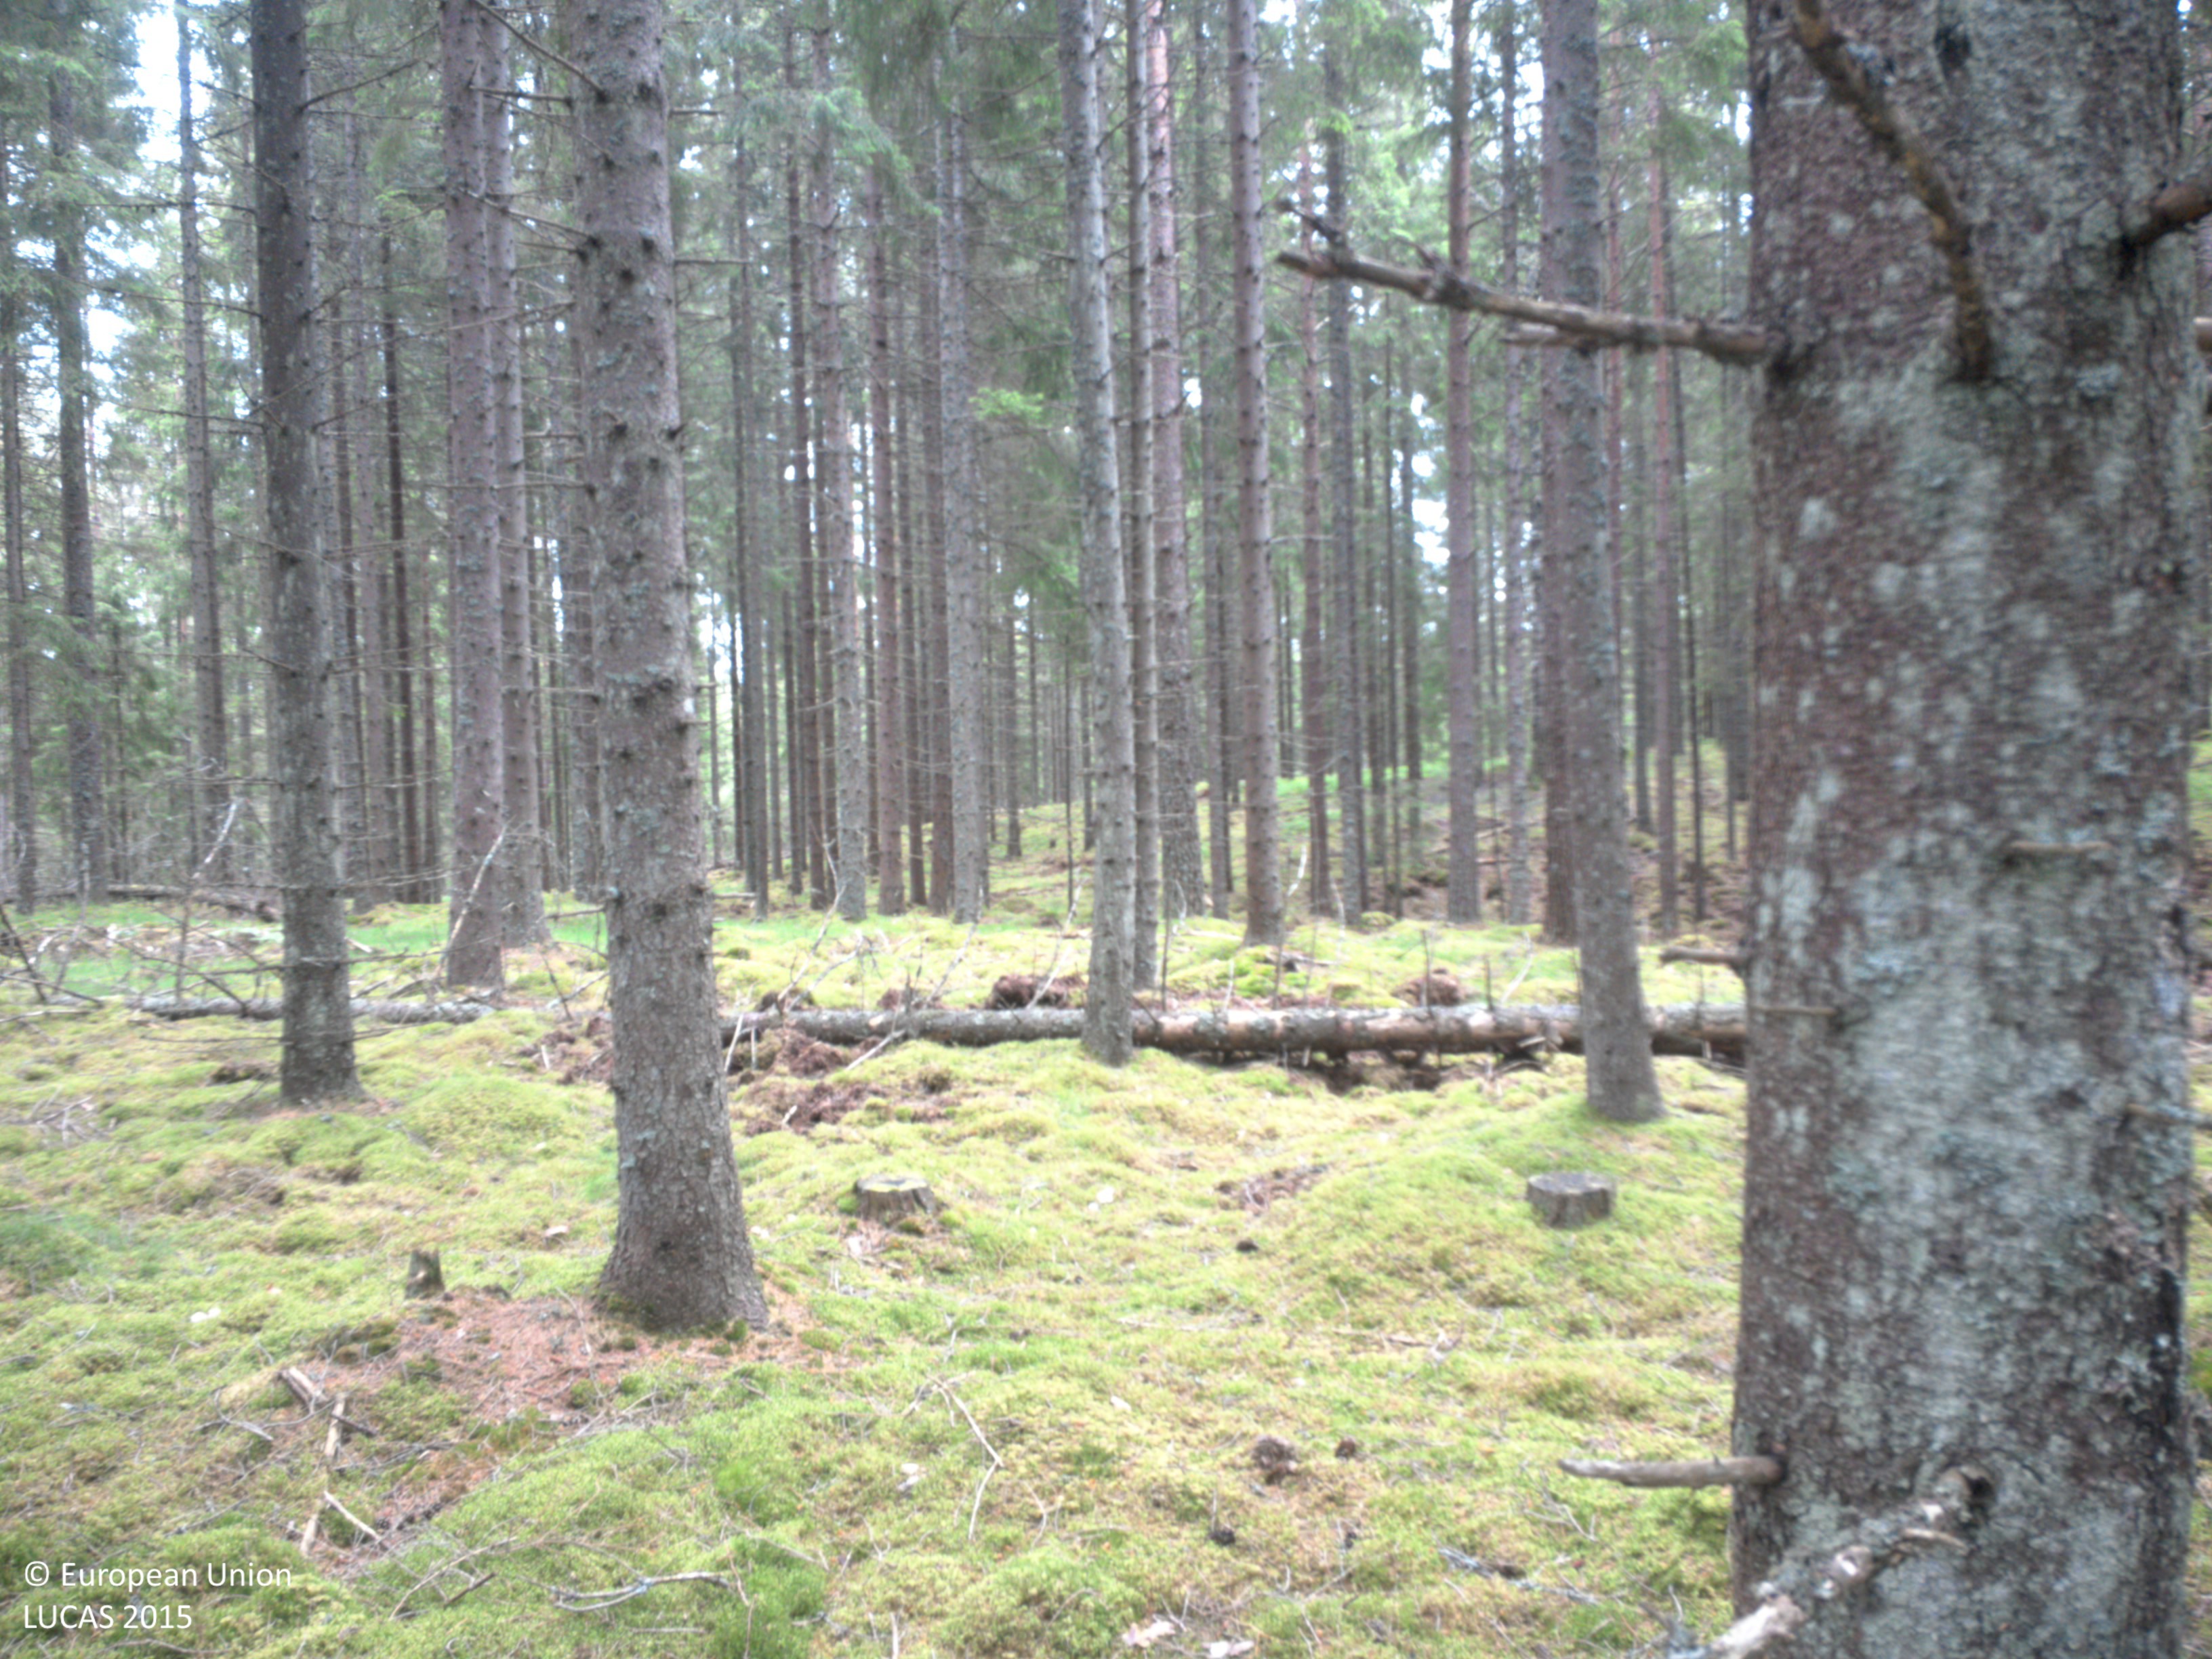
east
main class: Woodland
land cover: Spruce dominated coniferous woodland
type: boreal forest
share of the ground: 50 - 75 %
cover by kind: coniferous forest trees 65 %, lichens and mosses 35 %
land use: Forestry
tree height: > 5 m
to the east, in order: Spruce dominated coniferous woodland; Pine dominated coniferous woodland; Spruce dominated coniferous woodland; Rivers and streams; Spruce dominated coniferous woodland; Pine dominated coniferous woodland
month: June
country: SE
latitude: 58.9969
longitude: 11.9622
